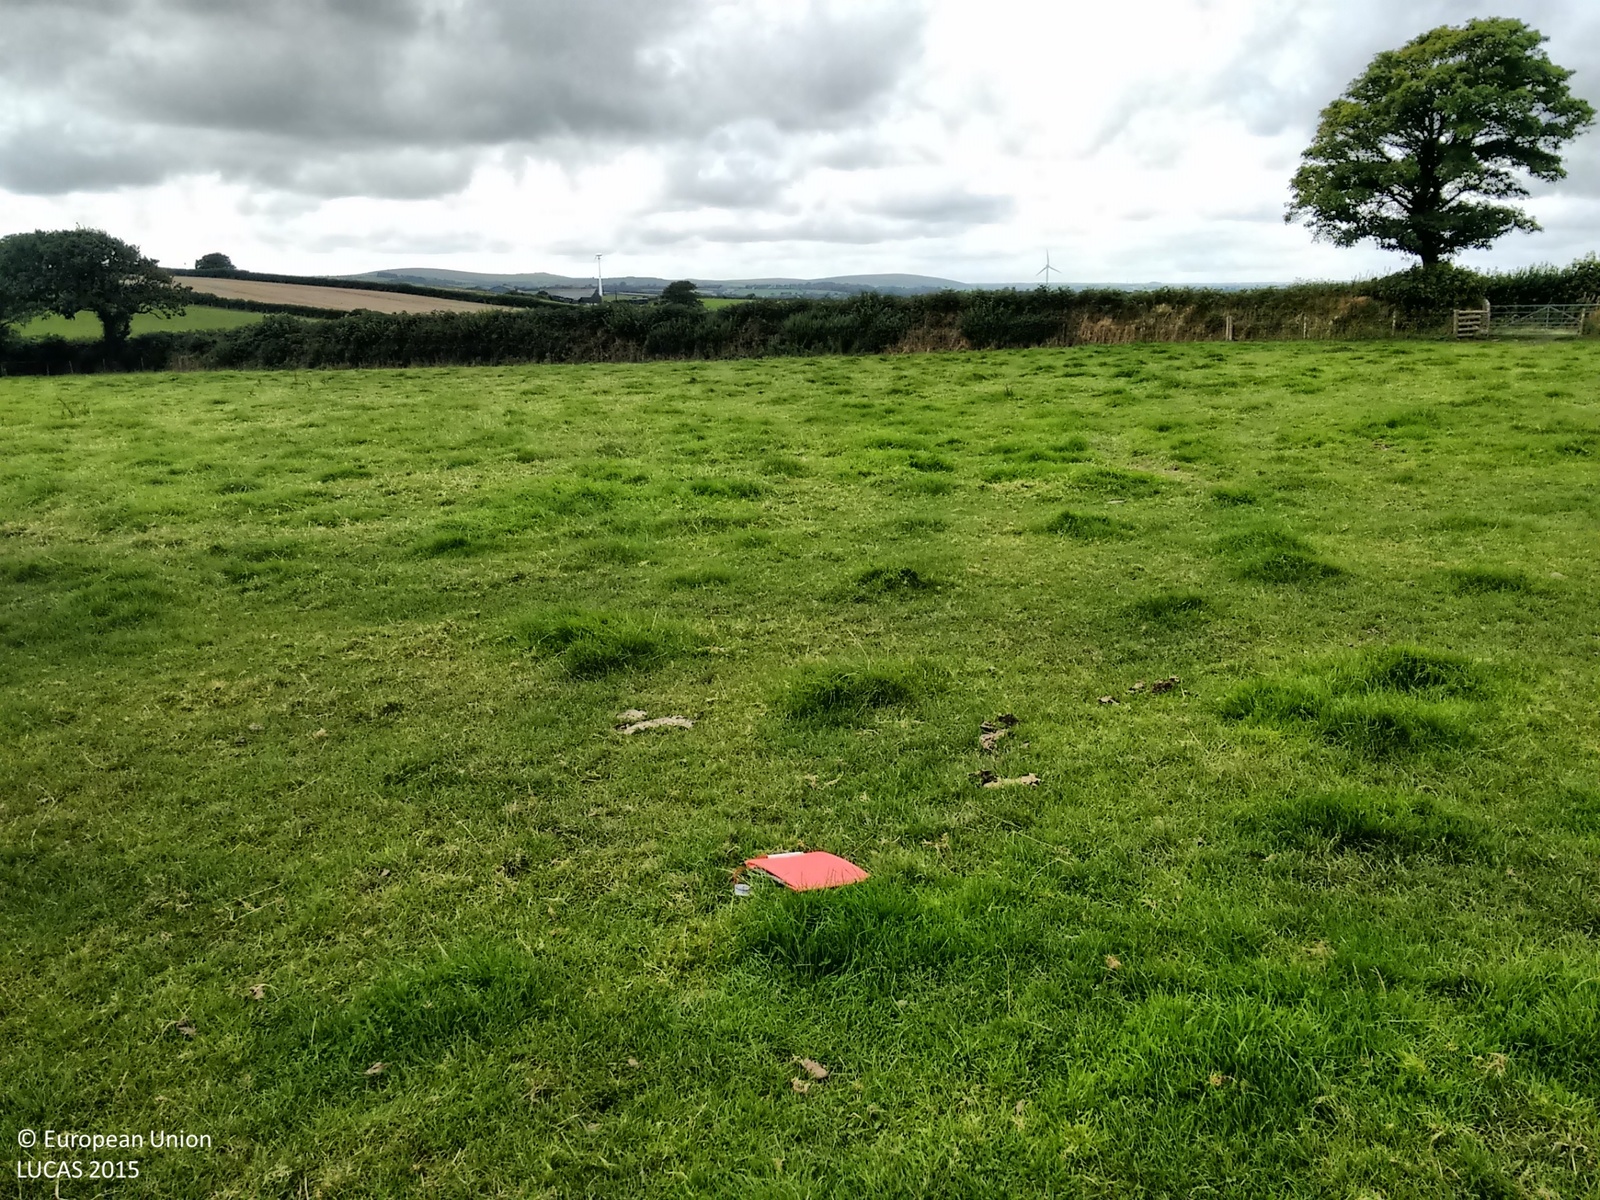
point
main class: Grassland
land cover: Grassland without tree/shrub cover
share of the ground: > 75 %
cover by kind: herbaceous plants 100 %
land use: Agriculture (excluding fallow land and kitchen gardens)
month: September
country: GB
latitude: 50.5925
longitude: -4.4411
